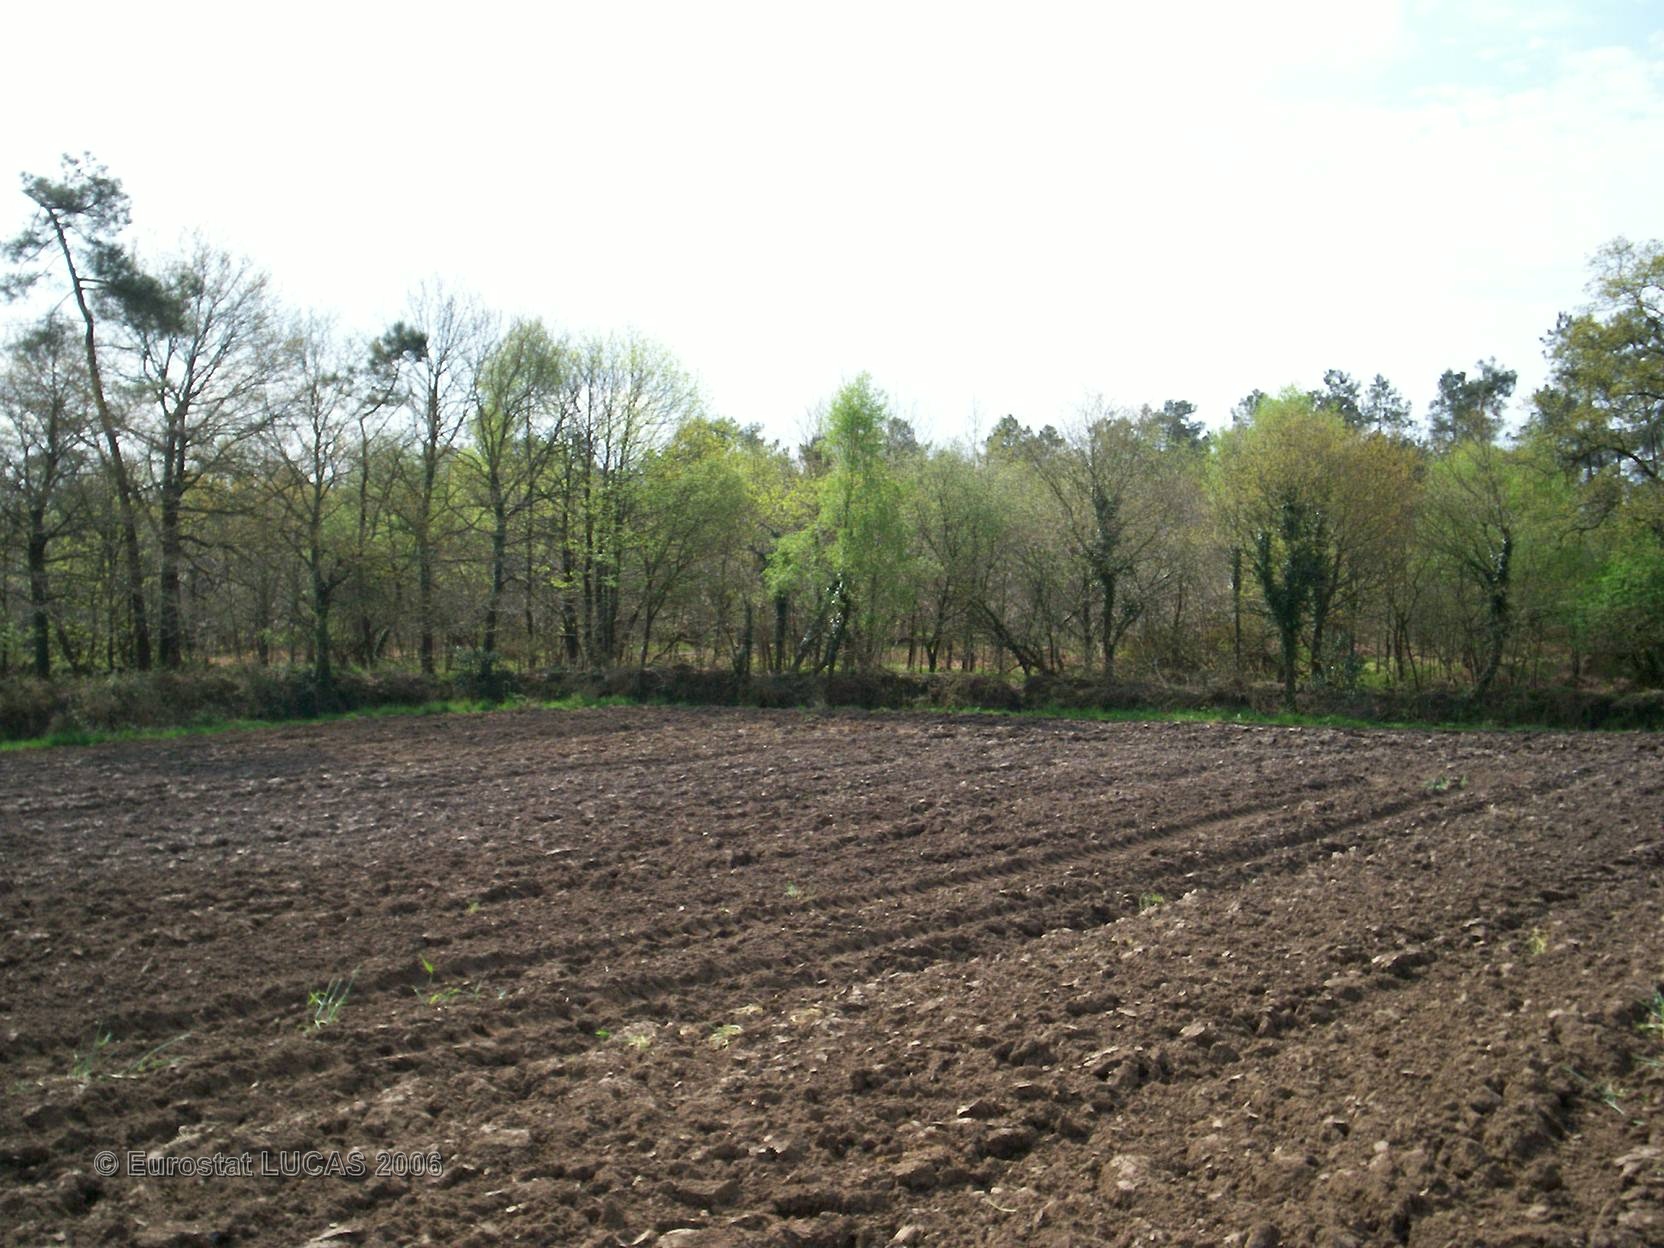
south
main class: Cropland
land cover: Maize
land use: Agriculture (excluding fallow land and kitchen gardens)
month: May
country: FR
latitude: 47.8030
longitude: -2.7876
